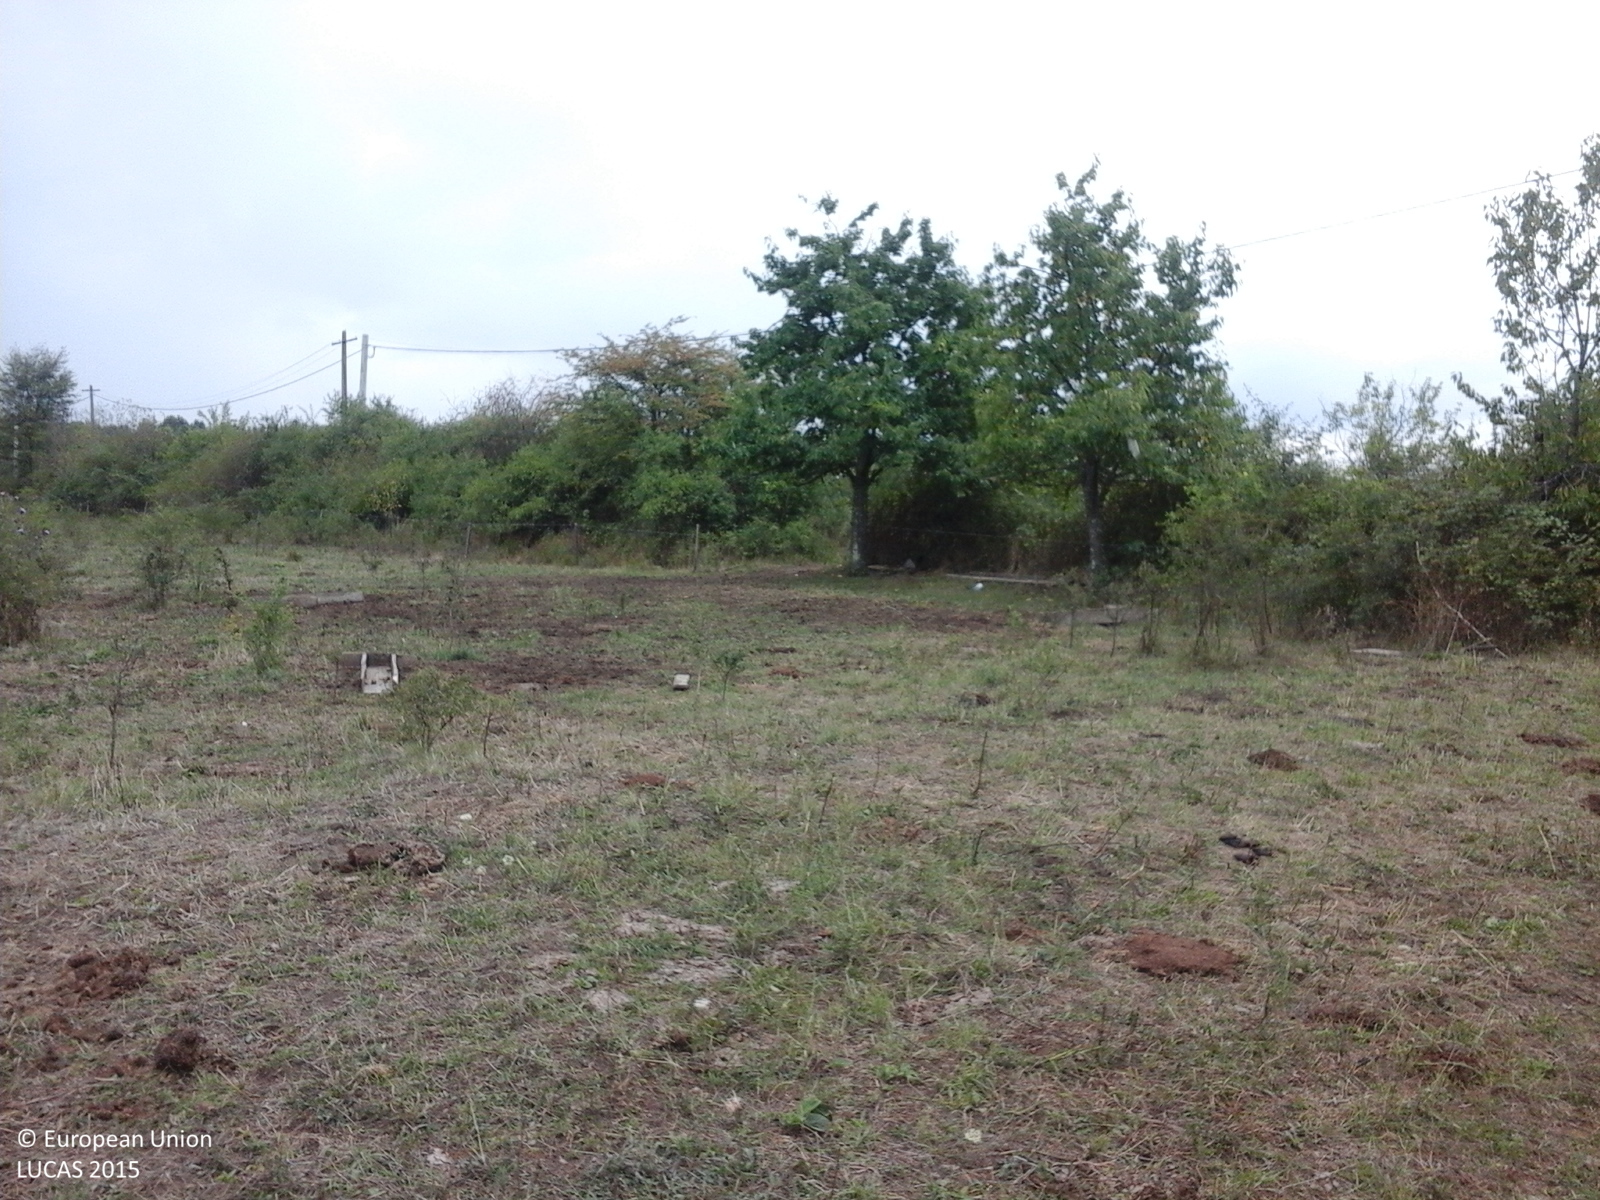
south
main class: Grassland
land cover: Grassland without tree/shrub cover
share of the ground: > 75 %
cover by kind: herbaceous plants 100 %
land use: Agriculture (excluding fallow land and kitchen gardens)
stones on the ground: < 10 %
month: August
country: RO
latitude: 45.4659
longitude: 21.7377
